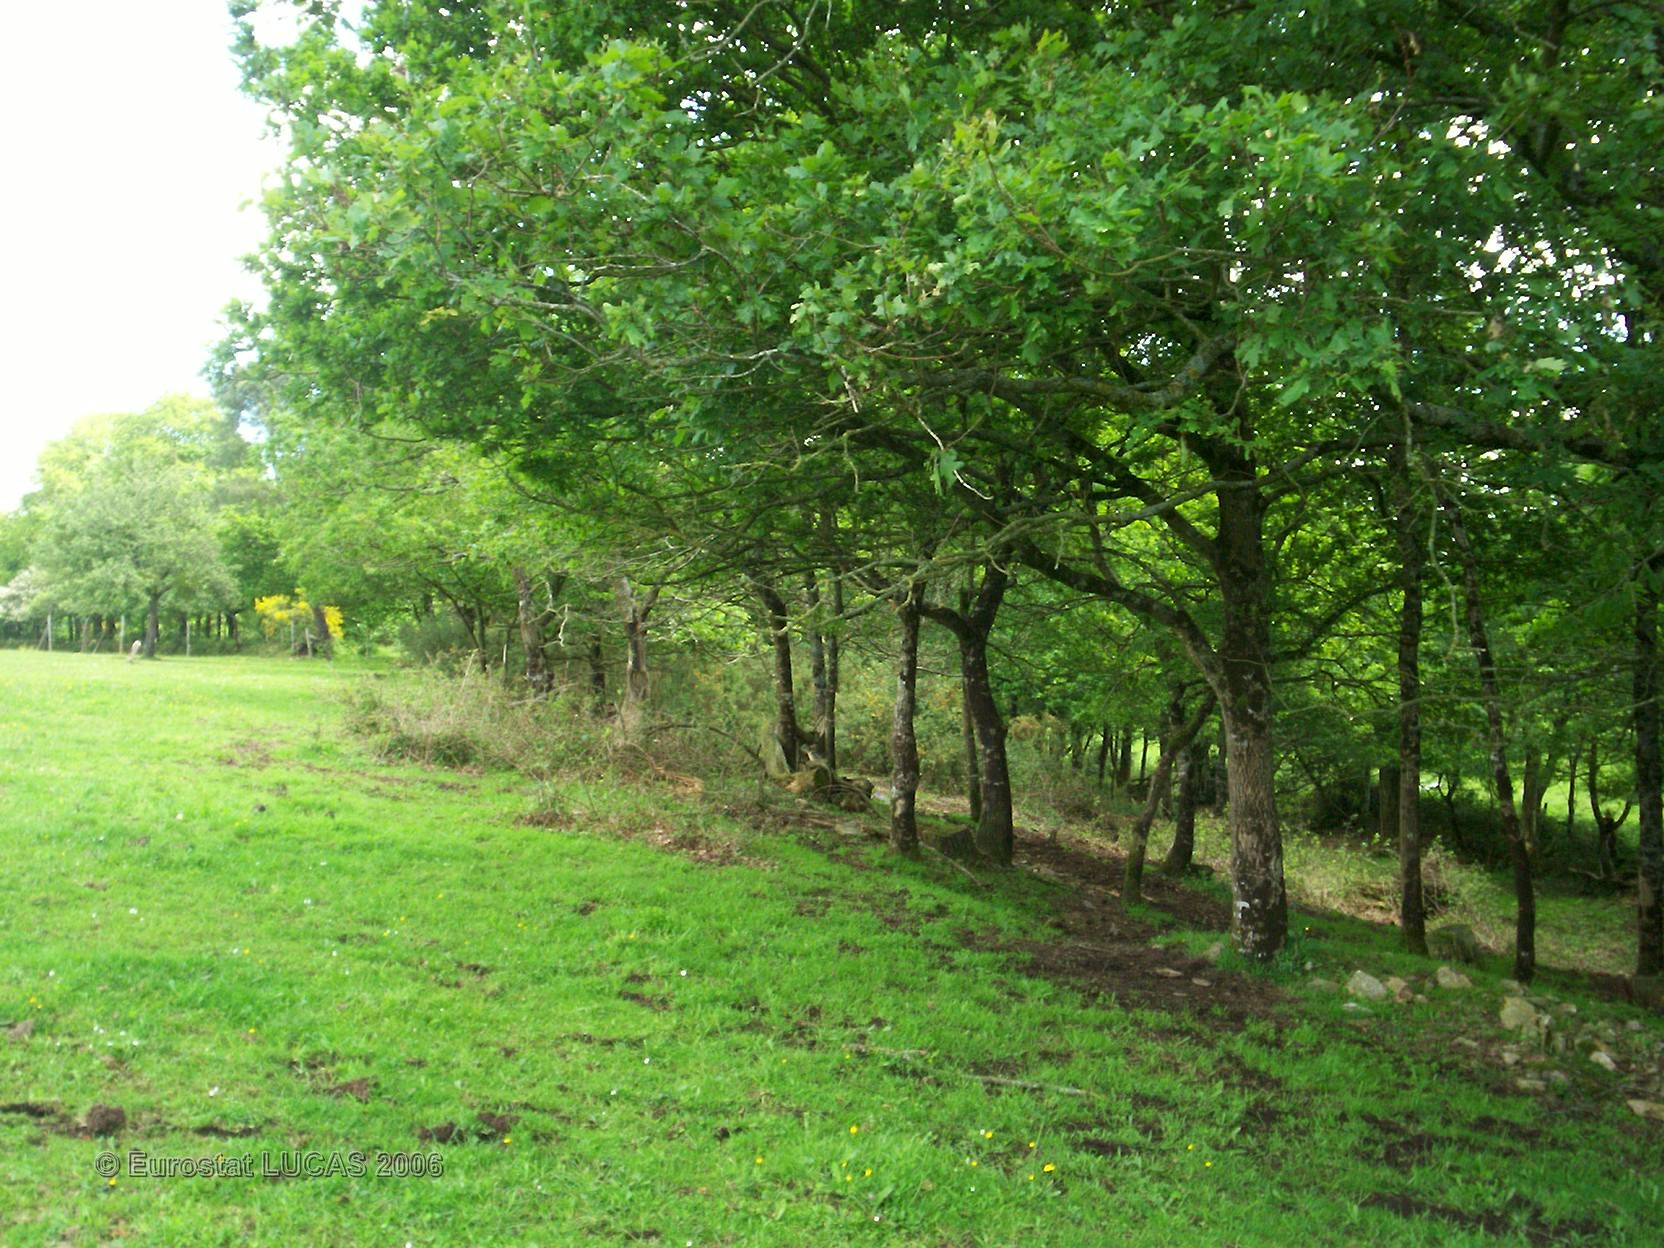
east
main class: Grassland
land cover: Grassland without tree/shrub cover
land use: Agriculture (excluding fallow land and kitchen gardens)
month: May
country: FR
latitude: 47.7292
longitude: -2.7961
